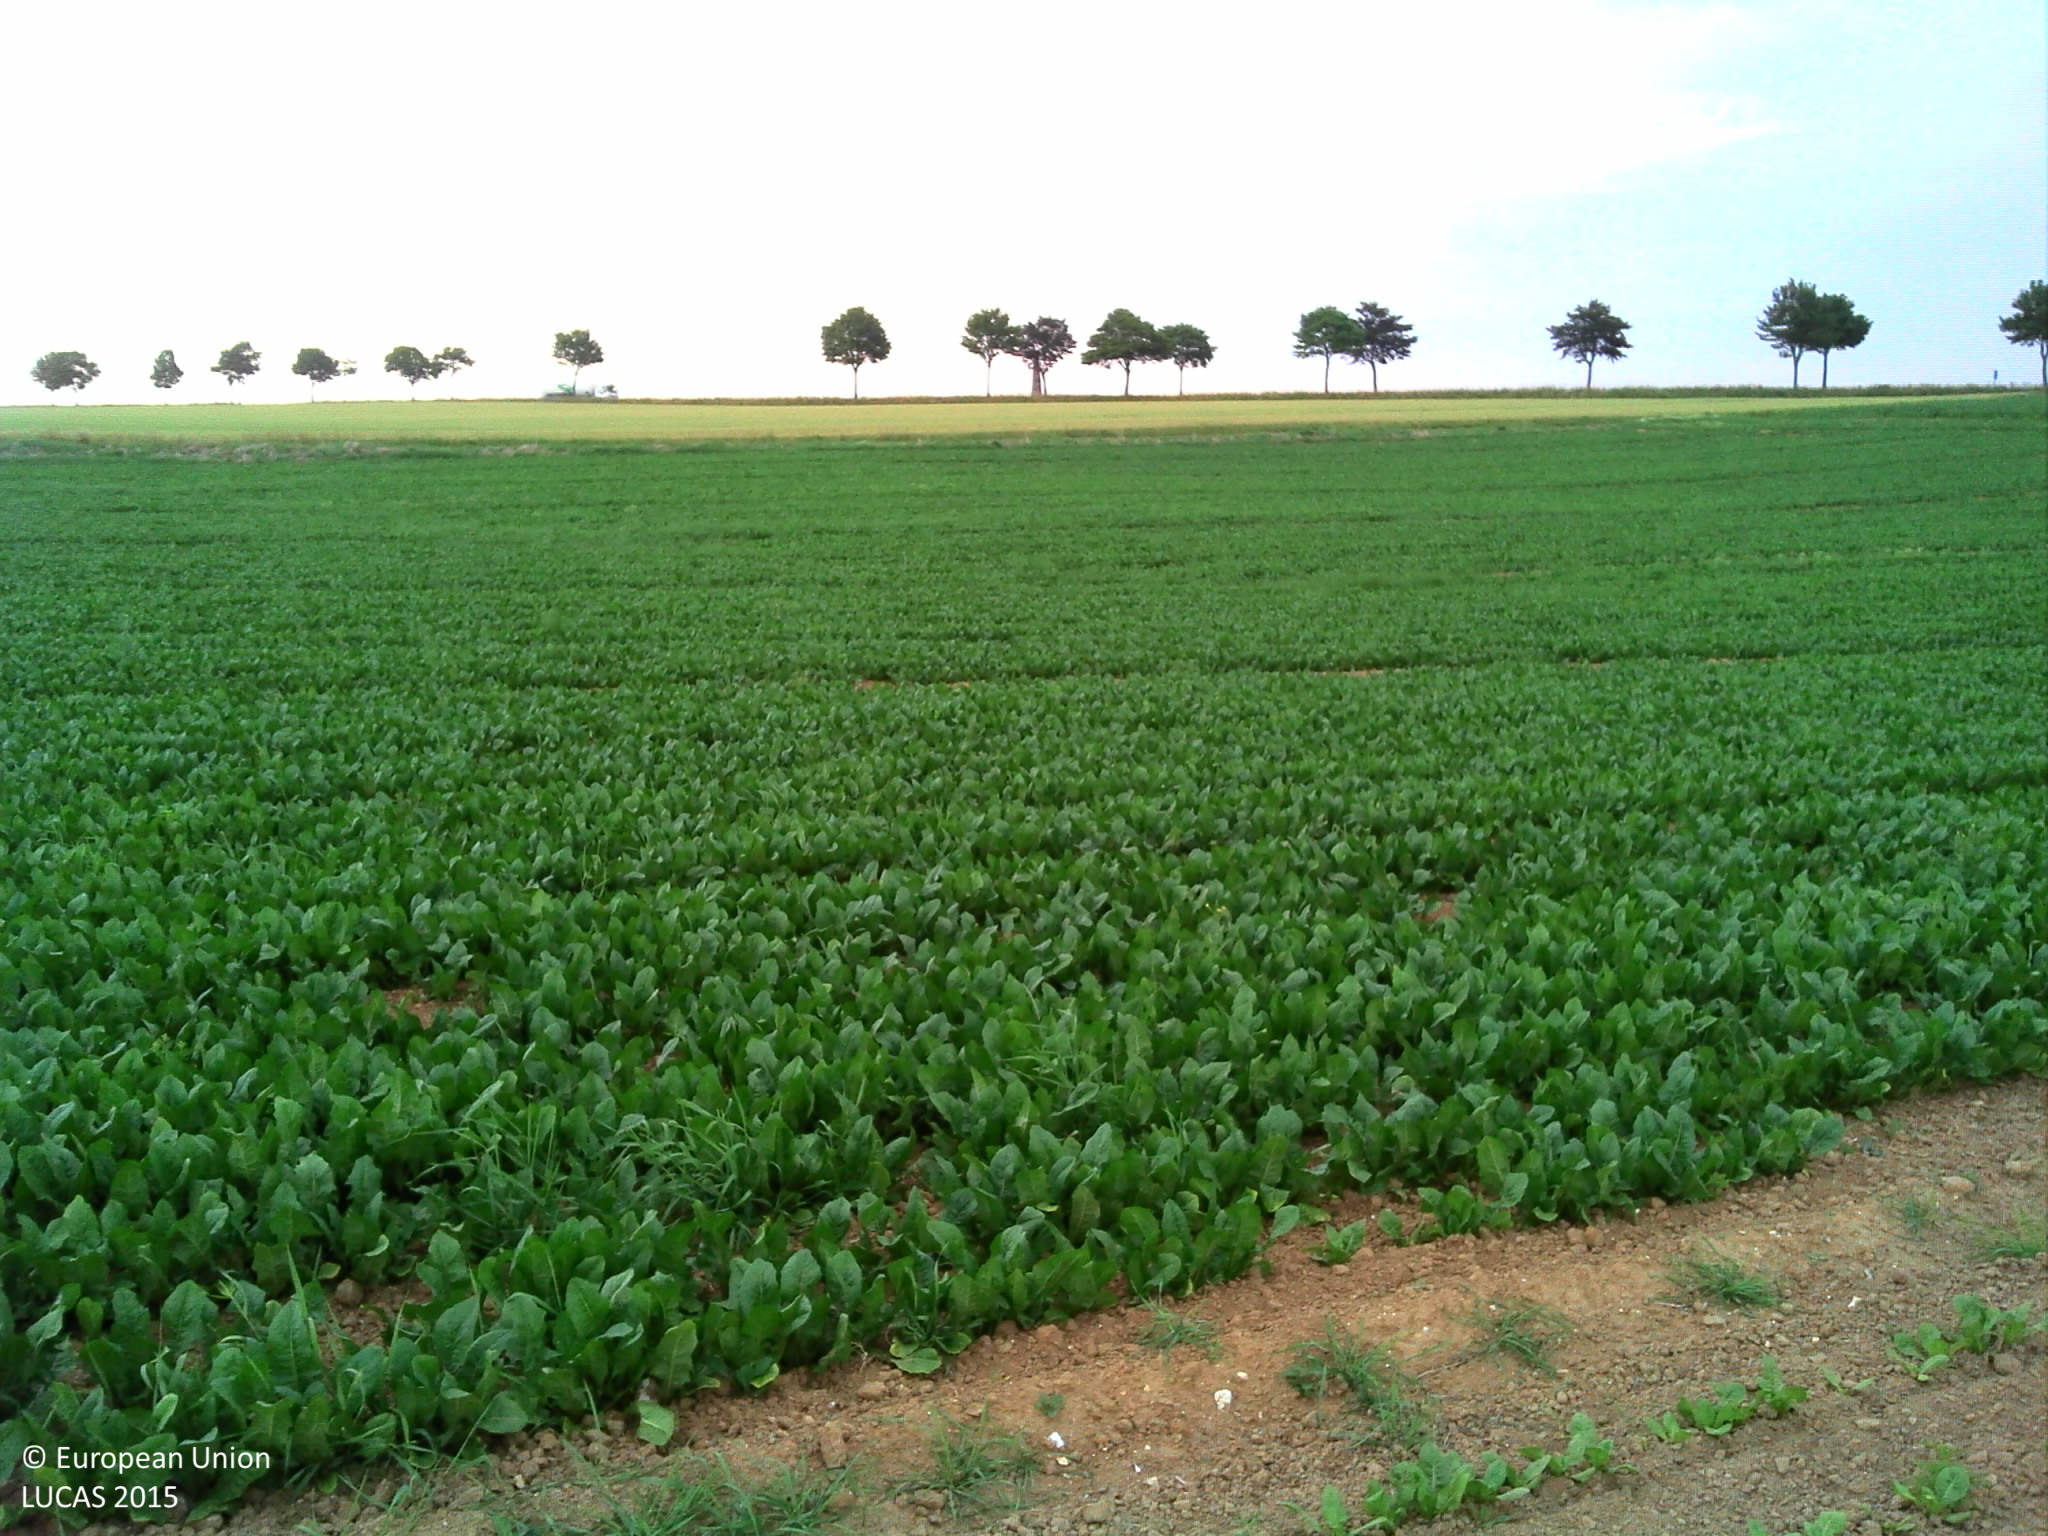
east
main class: Cropland
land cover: Other fresh vegetables
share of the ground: 10 - 25 %
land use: Agriculture (excluding fallow land and kitchen gardens)
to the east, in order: Other fresh vegetables; Grass margins; Tracks; Grass margins; Common wheat; Grass margins; Lines of trees; Grass margins; Paved roads, cycling and walking lanes; Grass margins
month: July
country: FR
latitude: 50.4508
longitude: 2.0839
